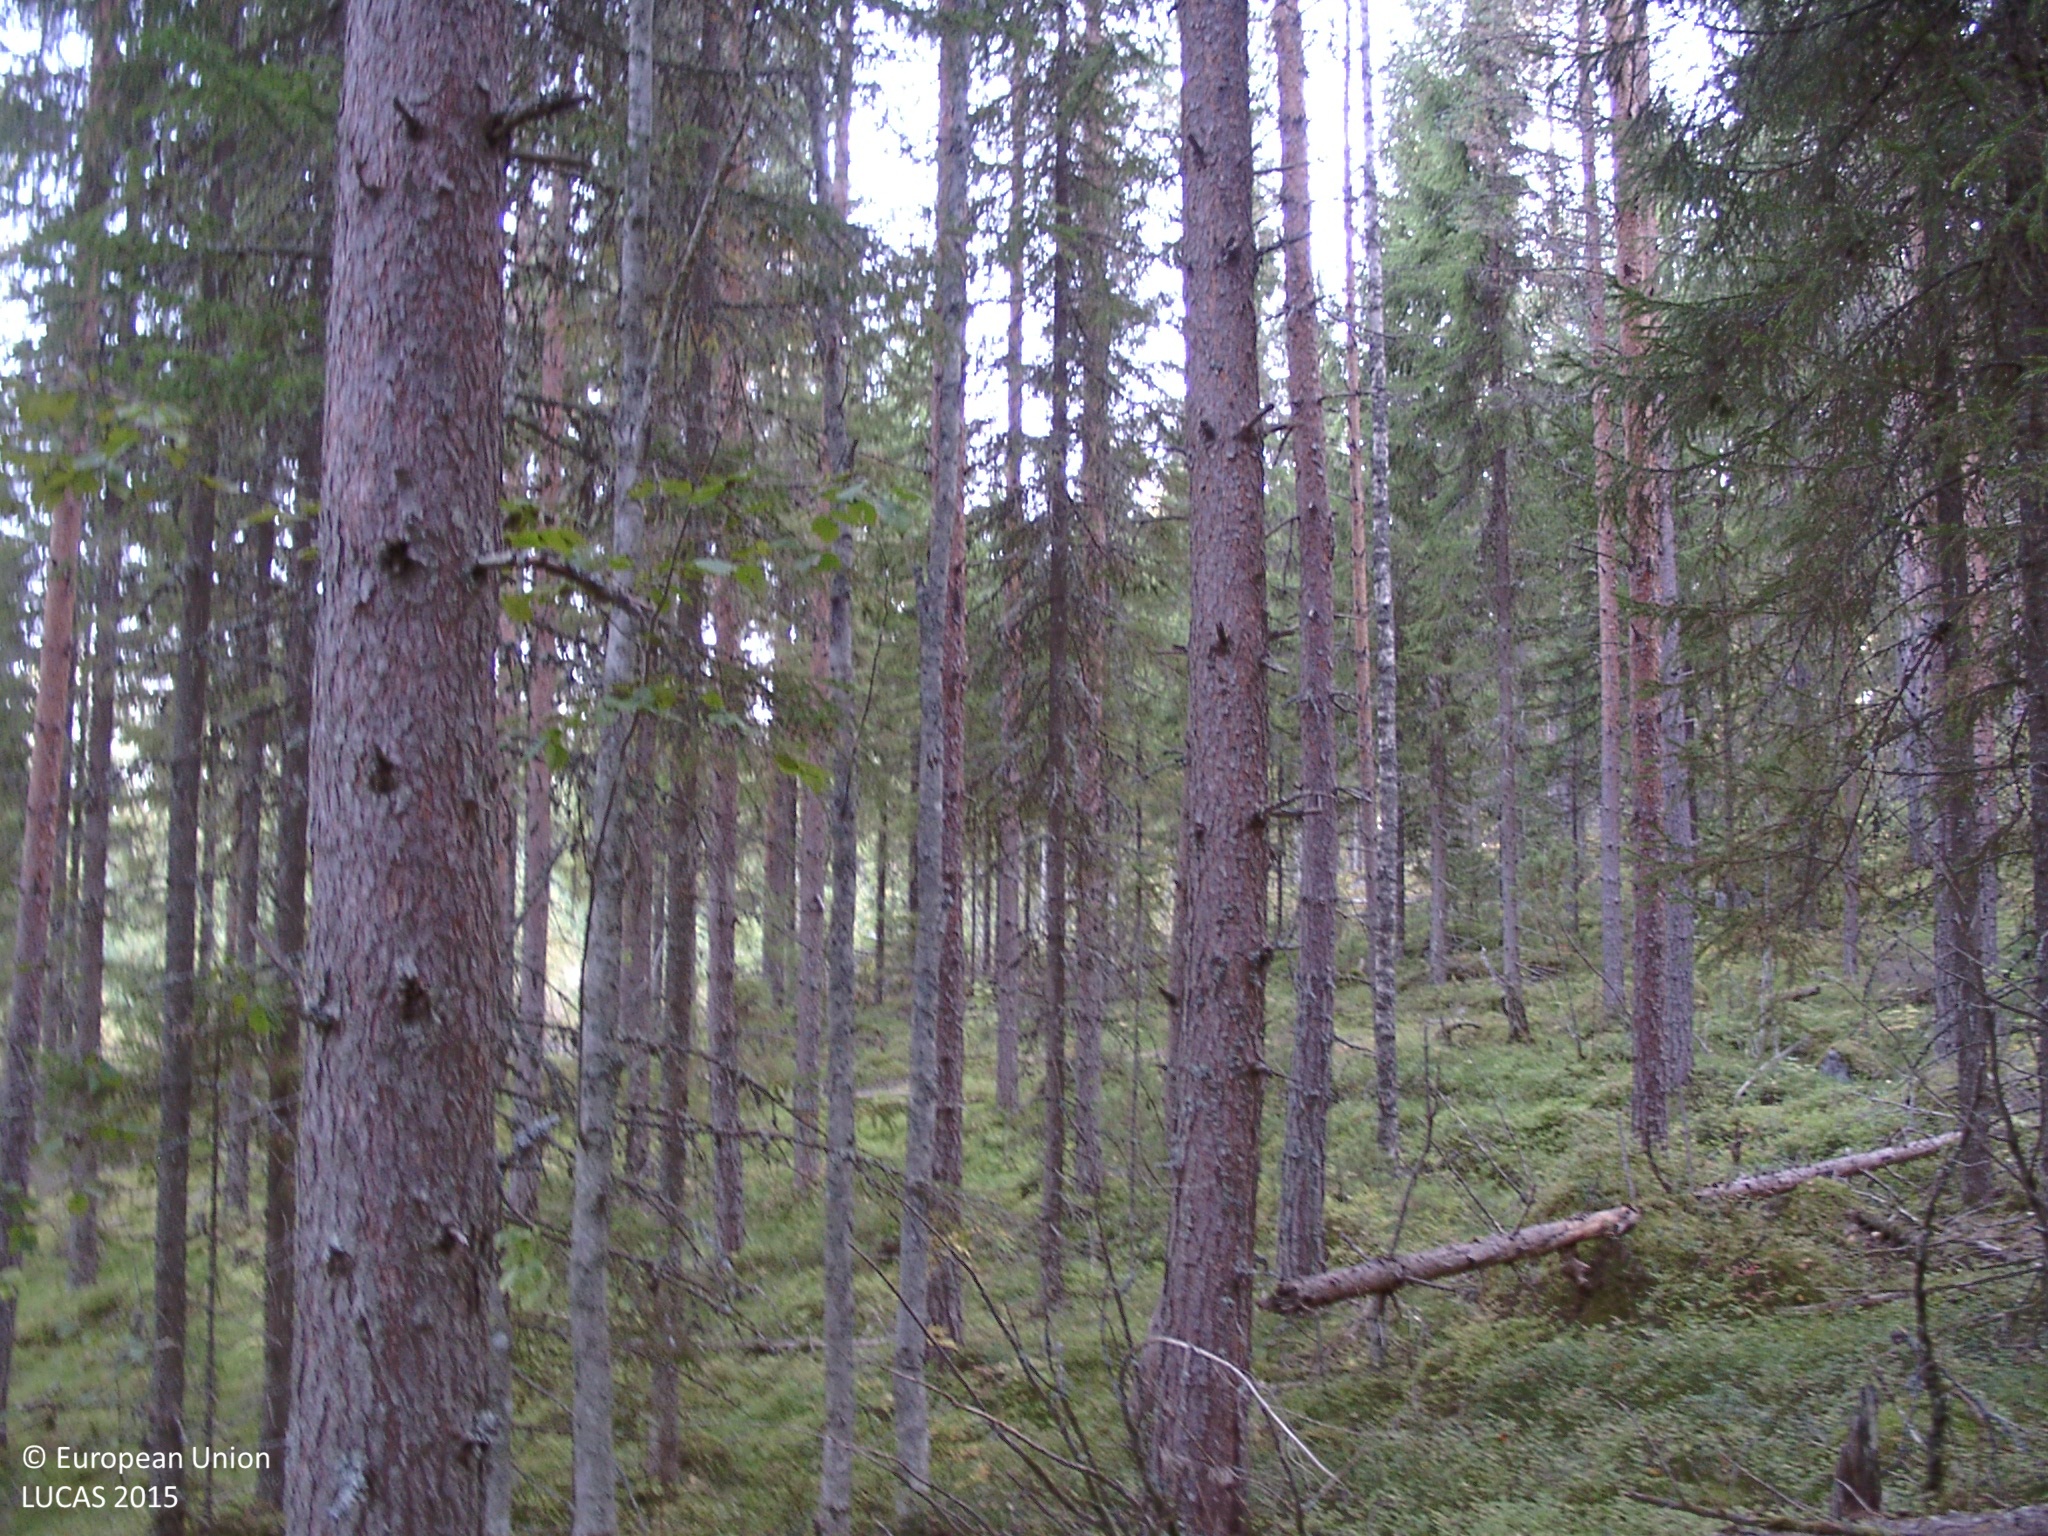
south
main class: Woodland
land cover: Other coniferous woodland
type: boreal forest
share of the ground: 50 - 75 %
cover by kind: coniferous forest trees 70 %, shrubs 15 %, lichens and mosses 10 %, herbaceous plants 5 %
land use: Forestry
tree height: > 5 m
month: September
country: FI
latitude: 62.4636
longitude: 25.5270
